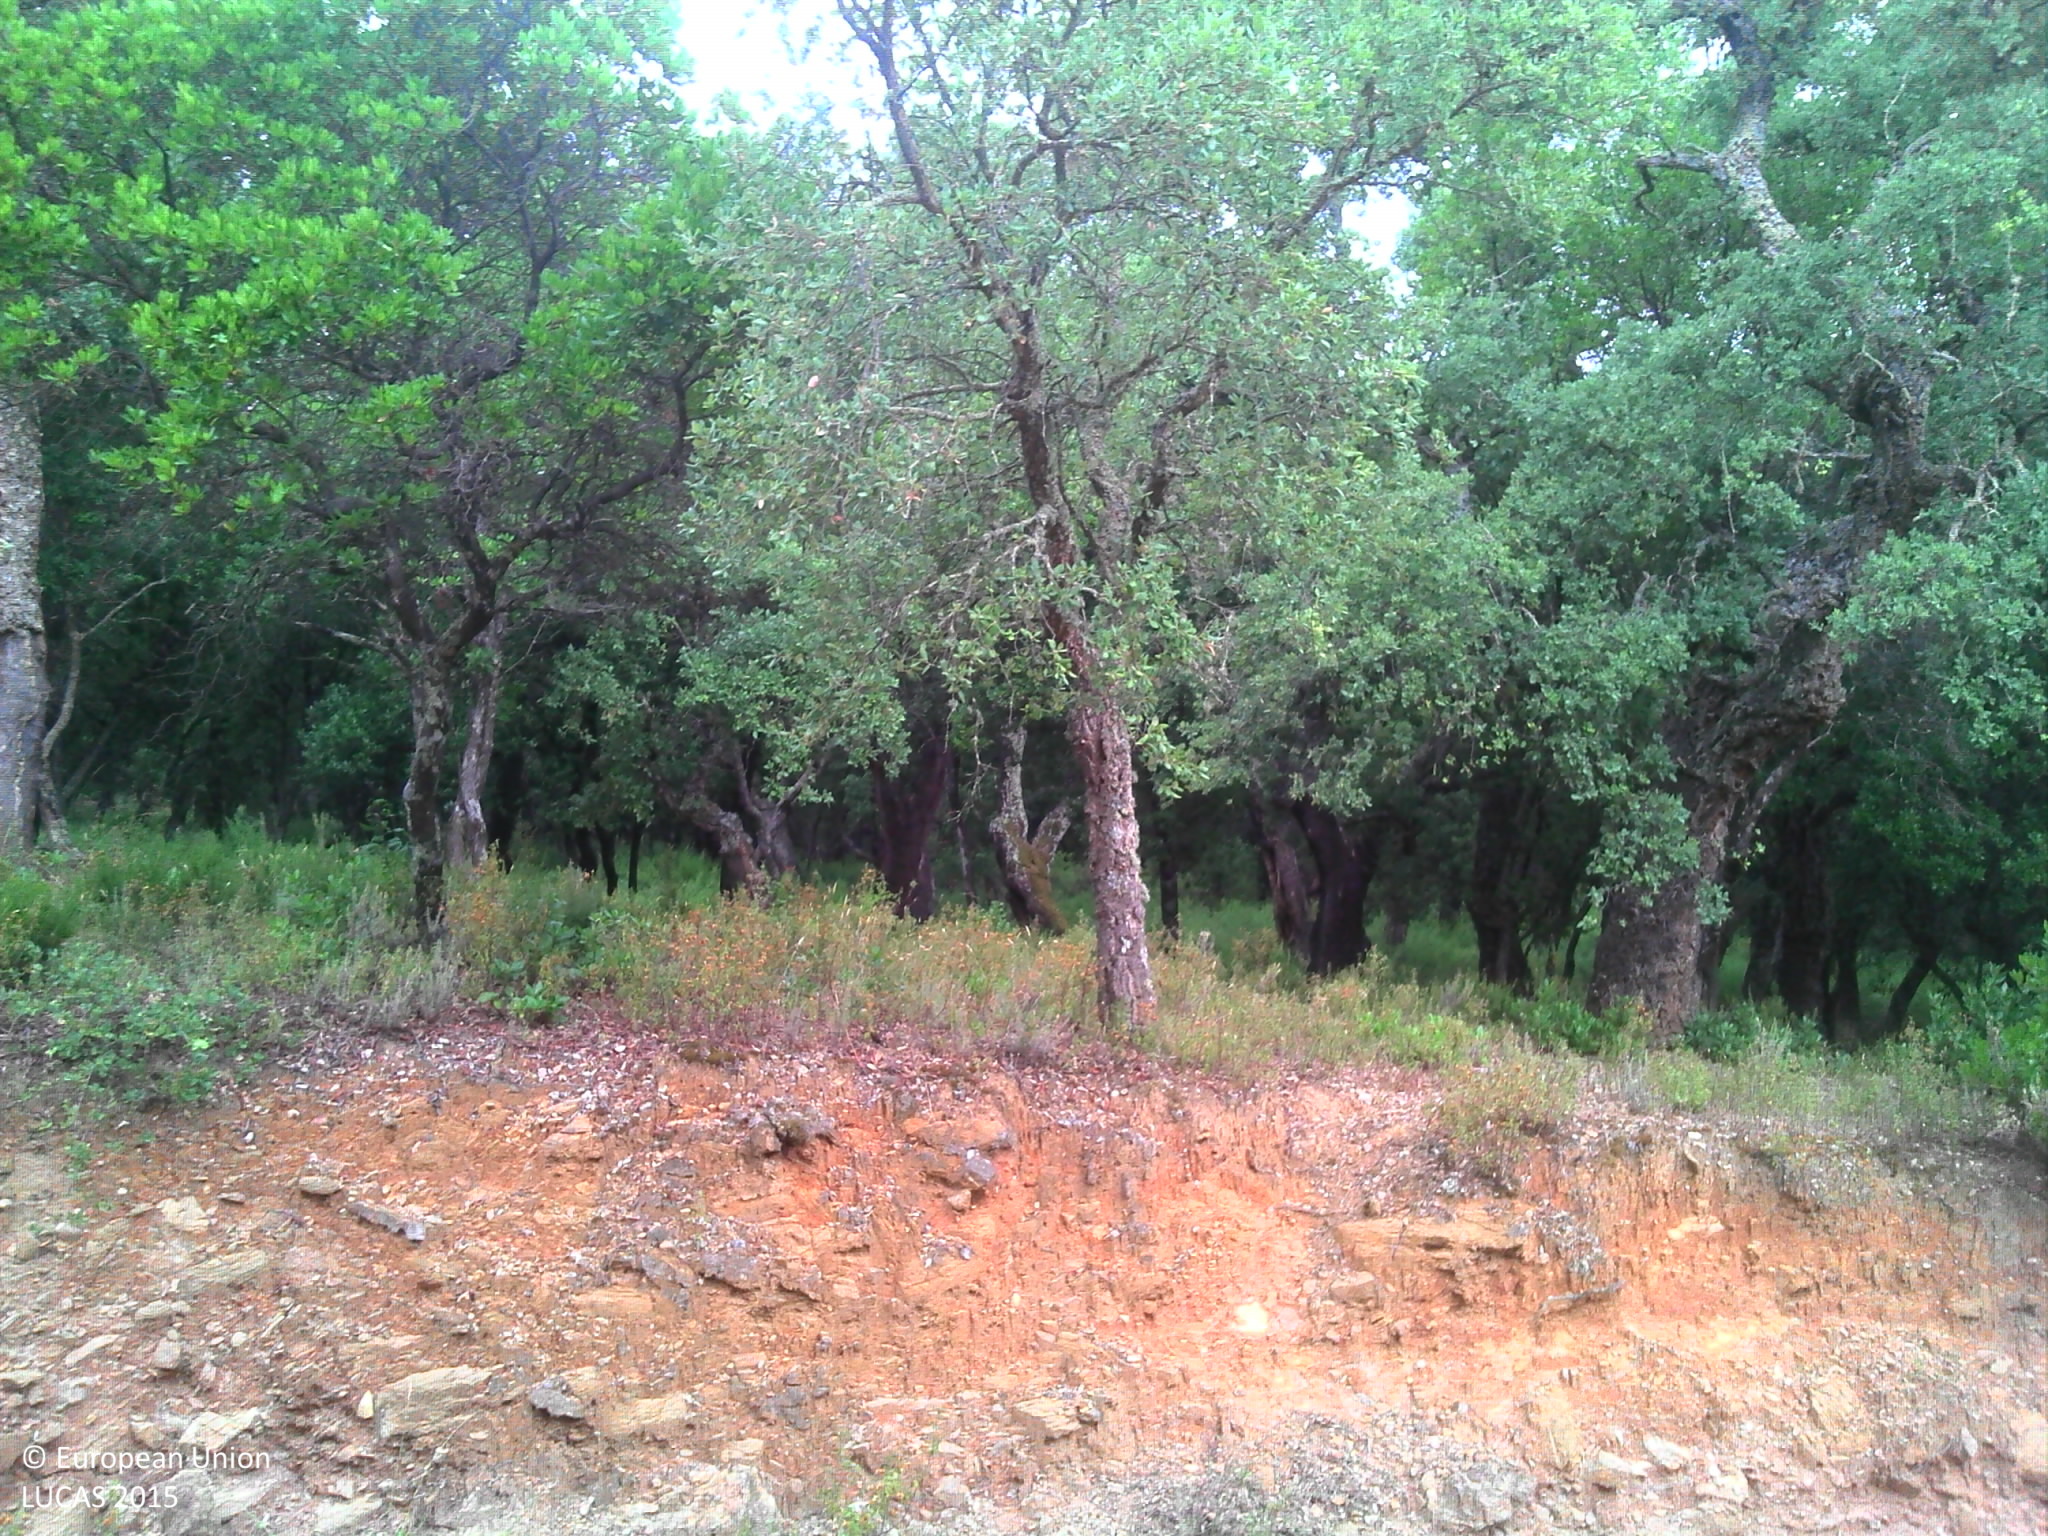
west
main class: Woodland
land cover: Broadleaved woodland
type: thermophilous deciduous forest
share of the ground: > 75 %
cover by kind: broadleaved forest trees 90 %, shrubs 10 %
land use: Forestry
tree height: > 5 m
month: July
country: FR
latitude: 43.3128
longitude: 6.3965
